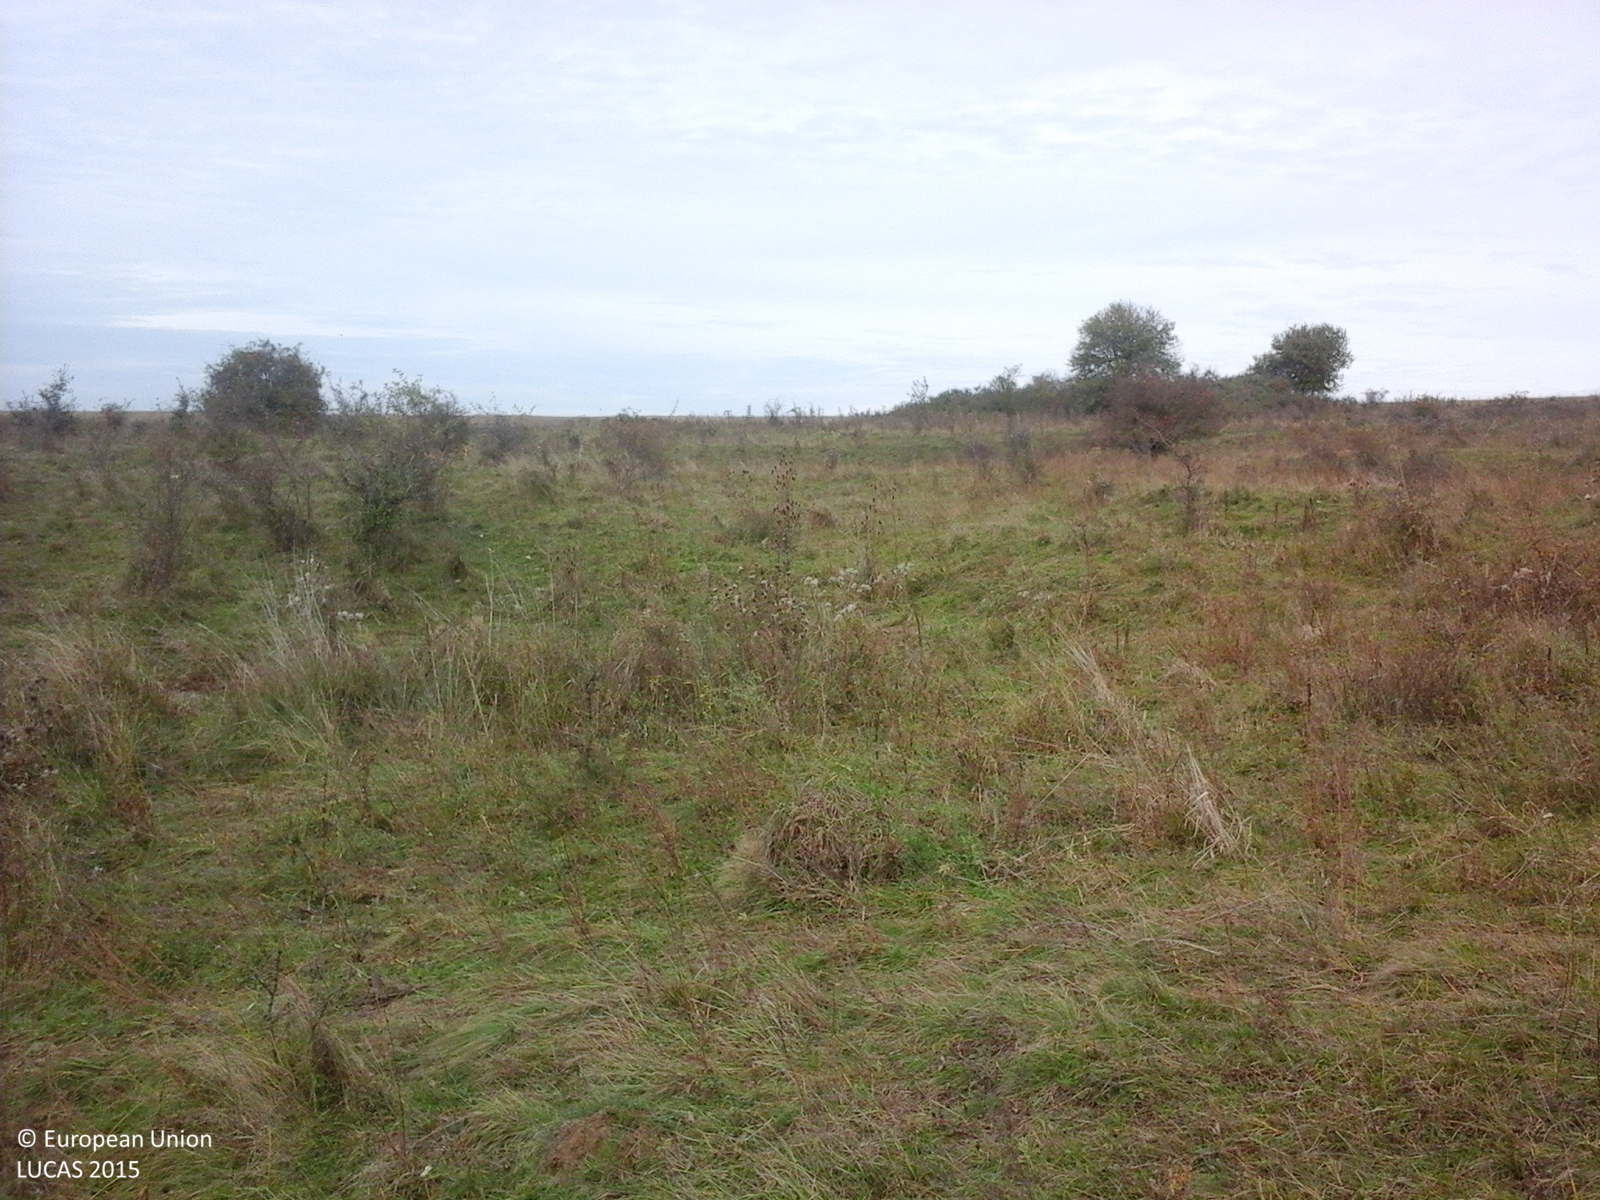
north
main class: Grassland
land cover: Spontaneously vegetated surfaces
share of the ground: > 75 %
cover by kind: herbaceous plants 100 %
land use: Fallow land
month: October
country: RO
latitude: 45.8612
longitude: 25.0740
